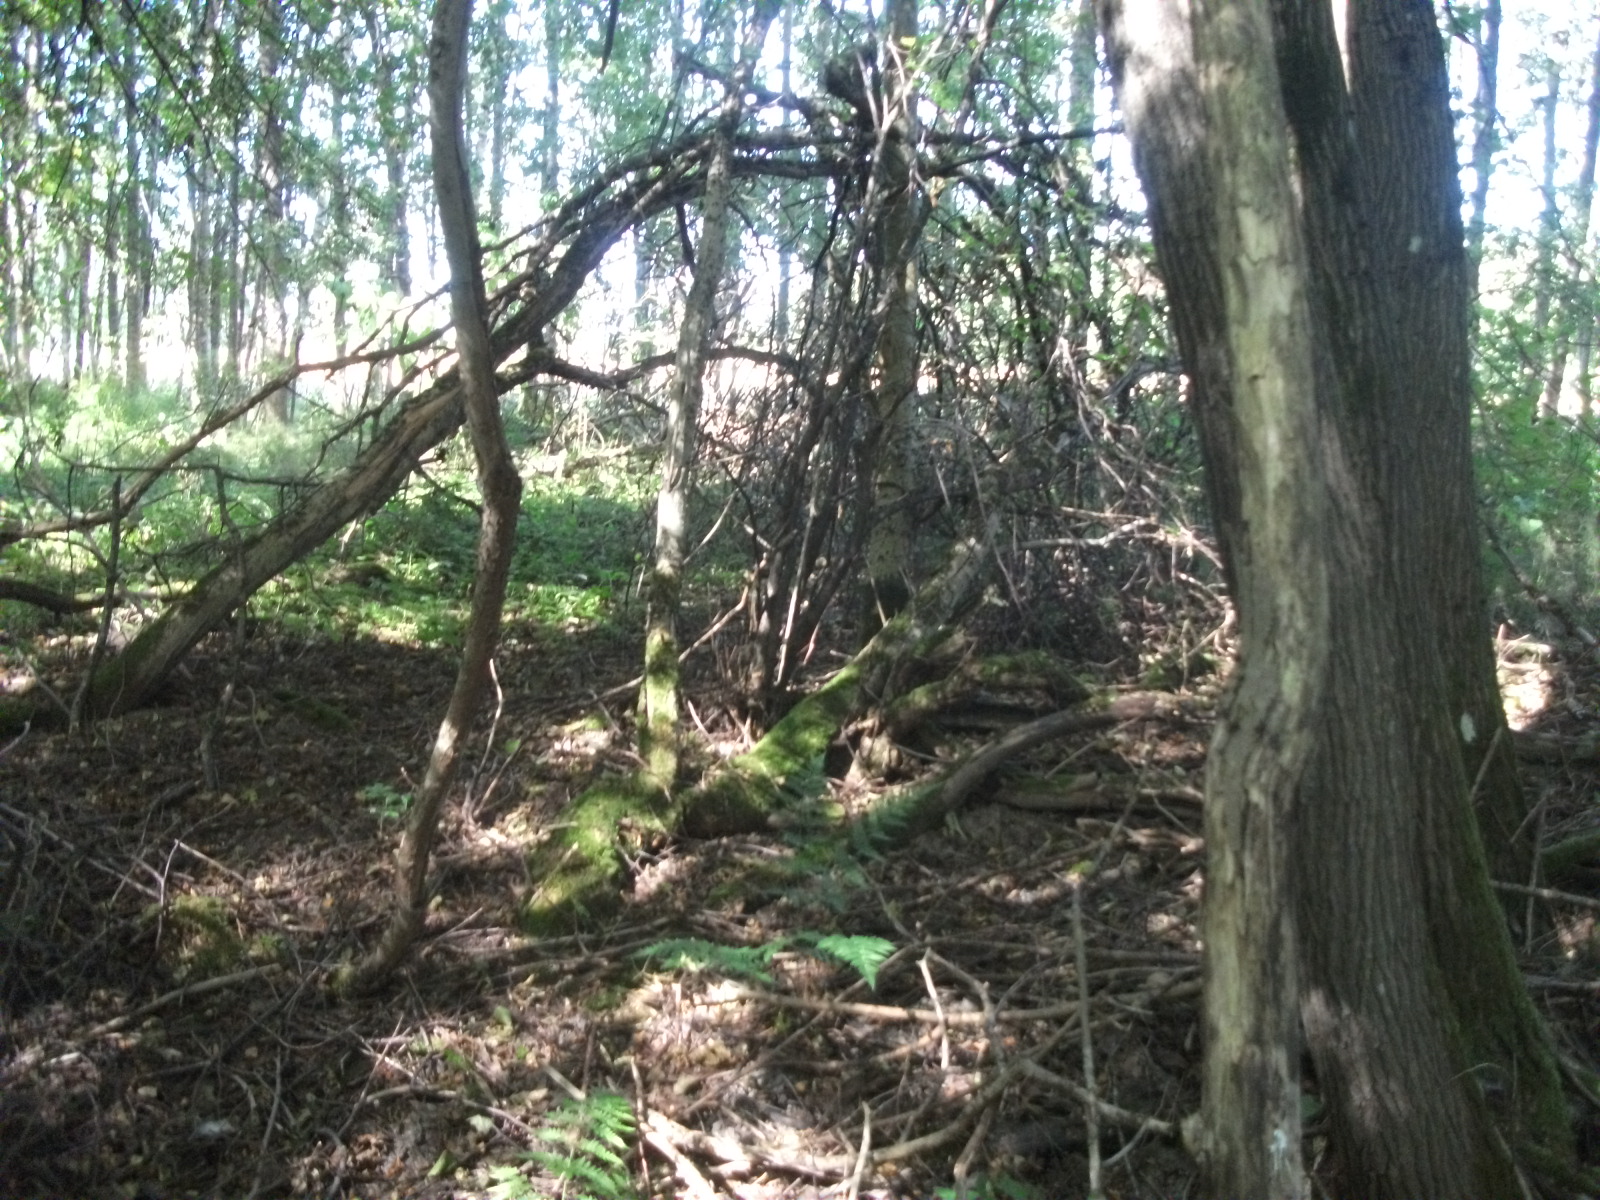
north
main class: Woodland
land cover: Broadleaved woodland
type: non-riverine alder, birch or aspen forest
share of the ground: > 75 %
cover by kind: broadleaved forest trees 95 %, shrubs 5 %
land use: Forestry
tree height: > 5 m
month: August
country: LV
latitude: 56.5237
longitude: 26.0823
